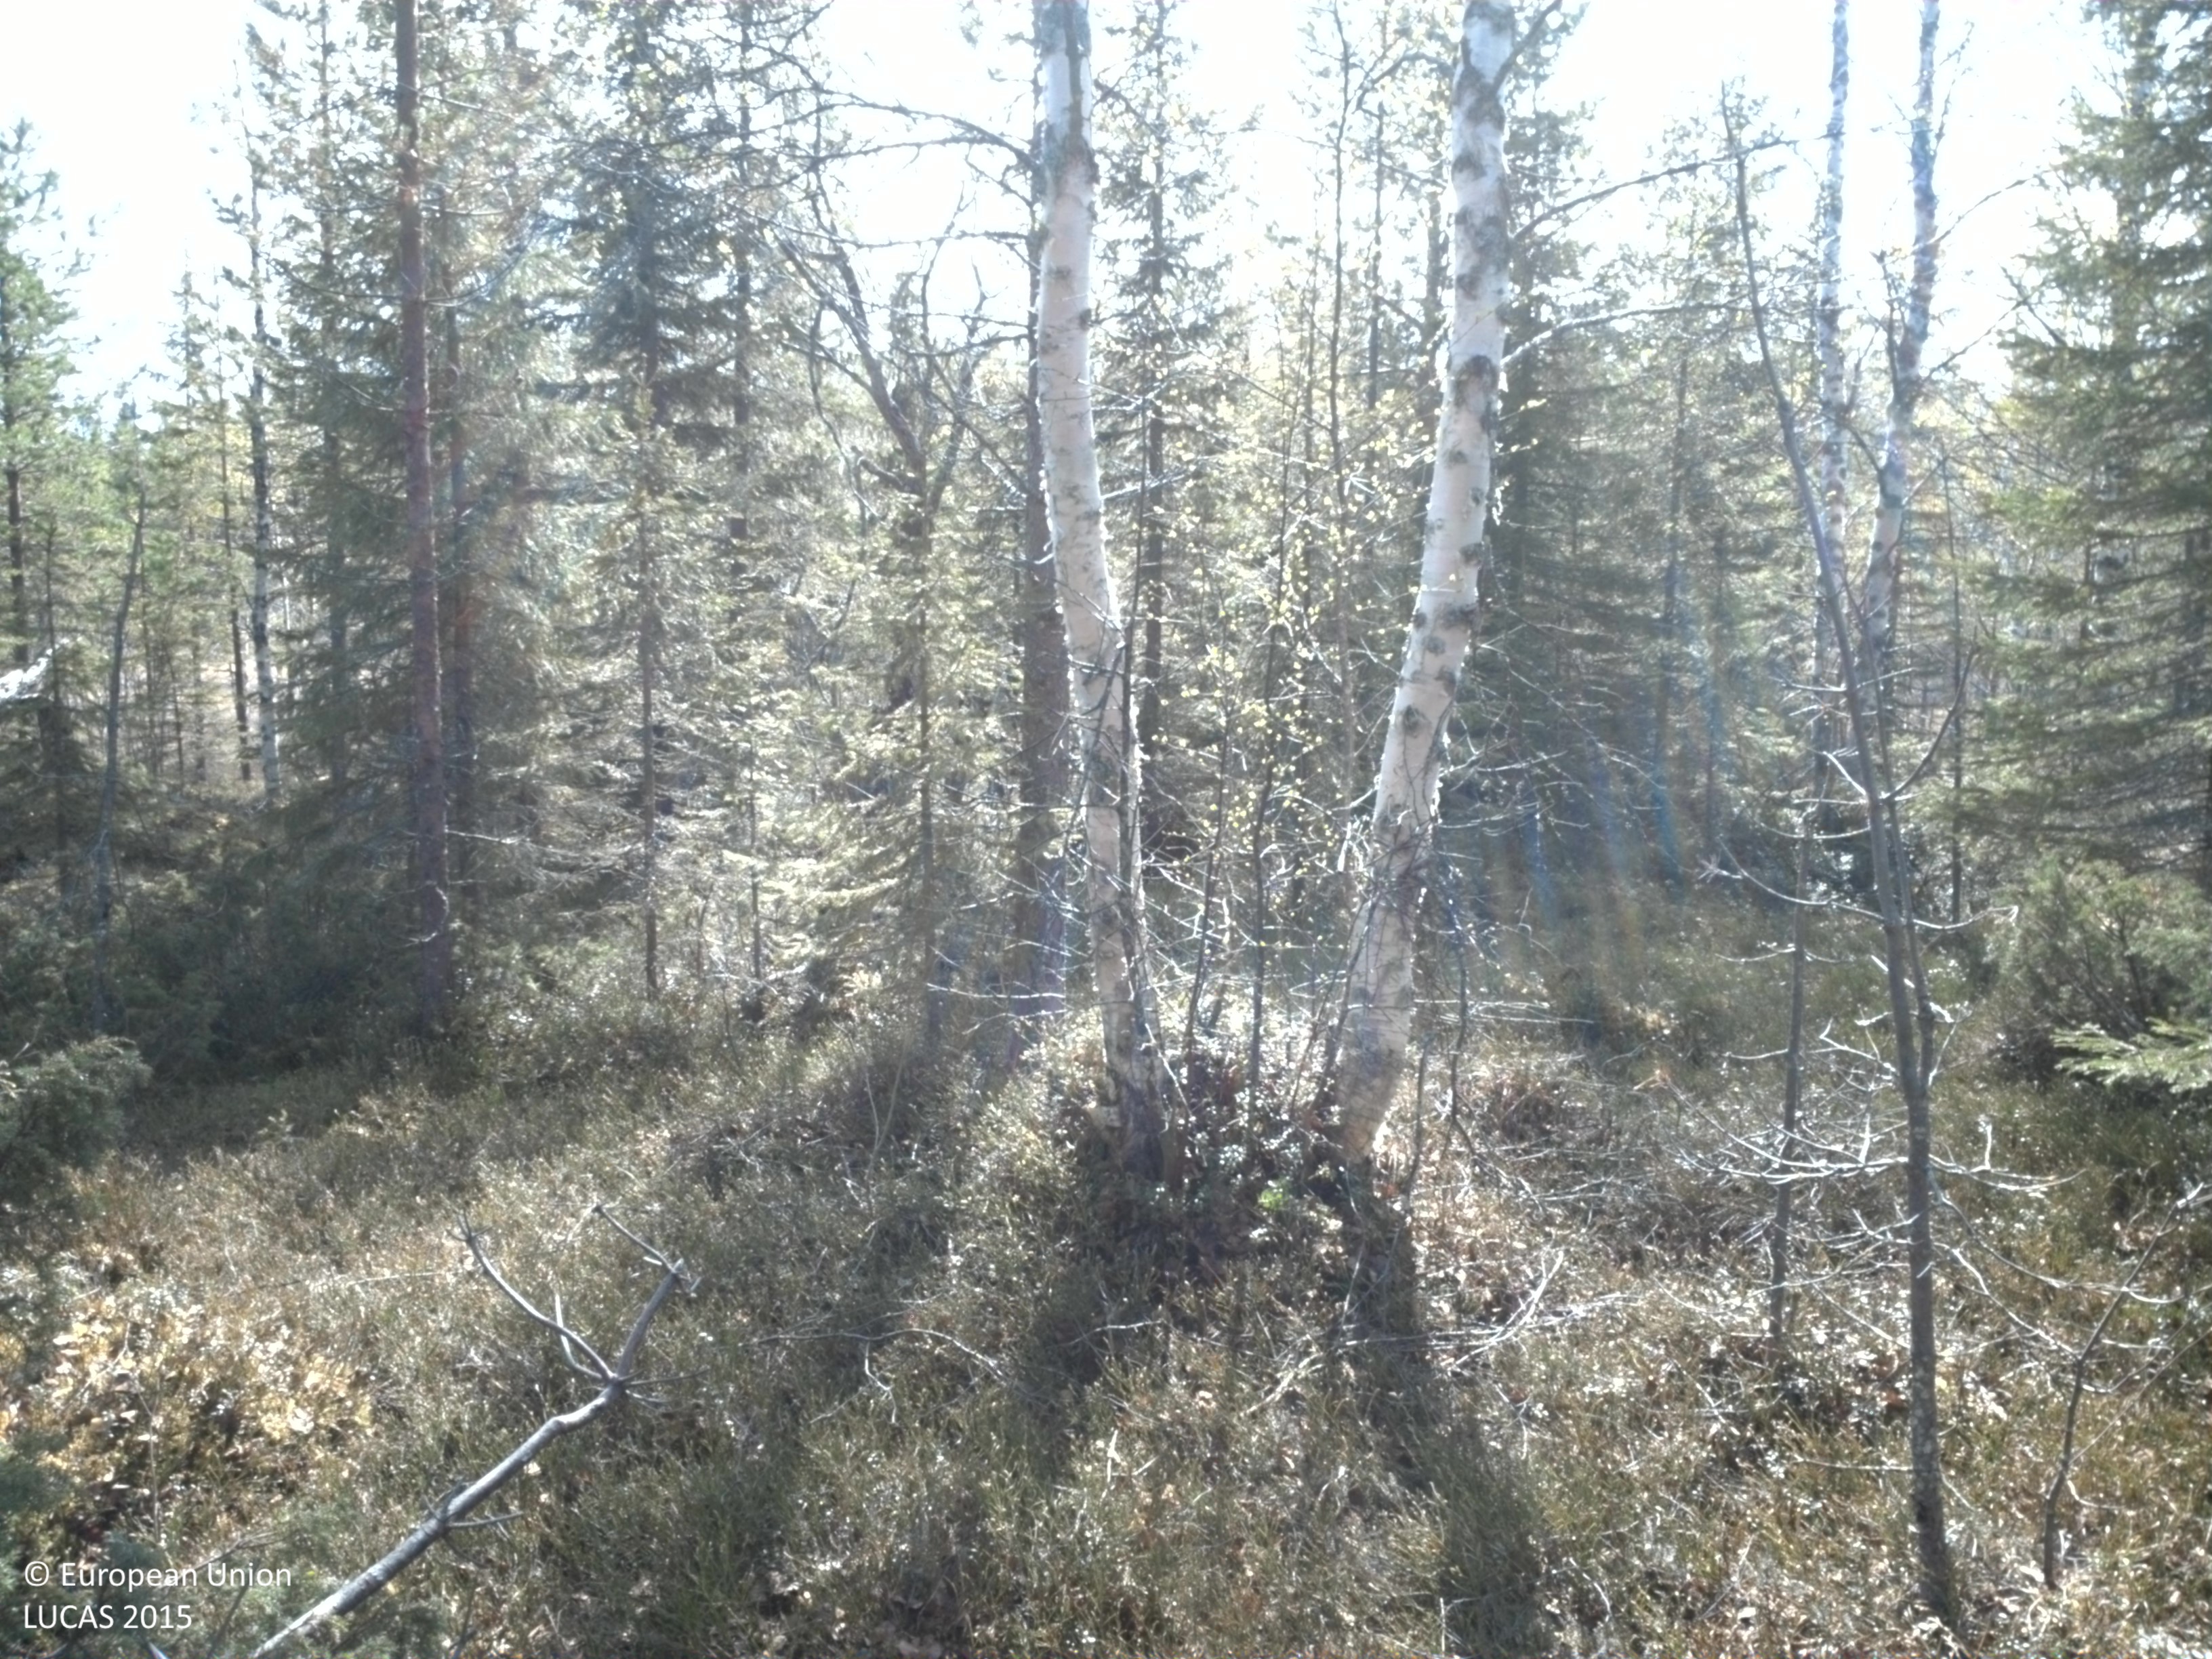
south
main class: Woodland
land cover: Pine dominated coniferous woodland
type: boreal forest
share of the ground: 50 - 75 %
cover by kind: coniferous forest trees 55 %, shrubs 35 %, broadleaved forest trees 10 %
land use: Forestry
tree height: < 5 m
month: May
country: SE
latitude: 66.1552
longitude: 23.2642
